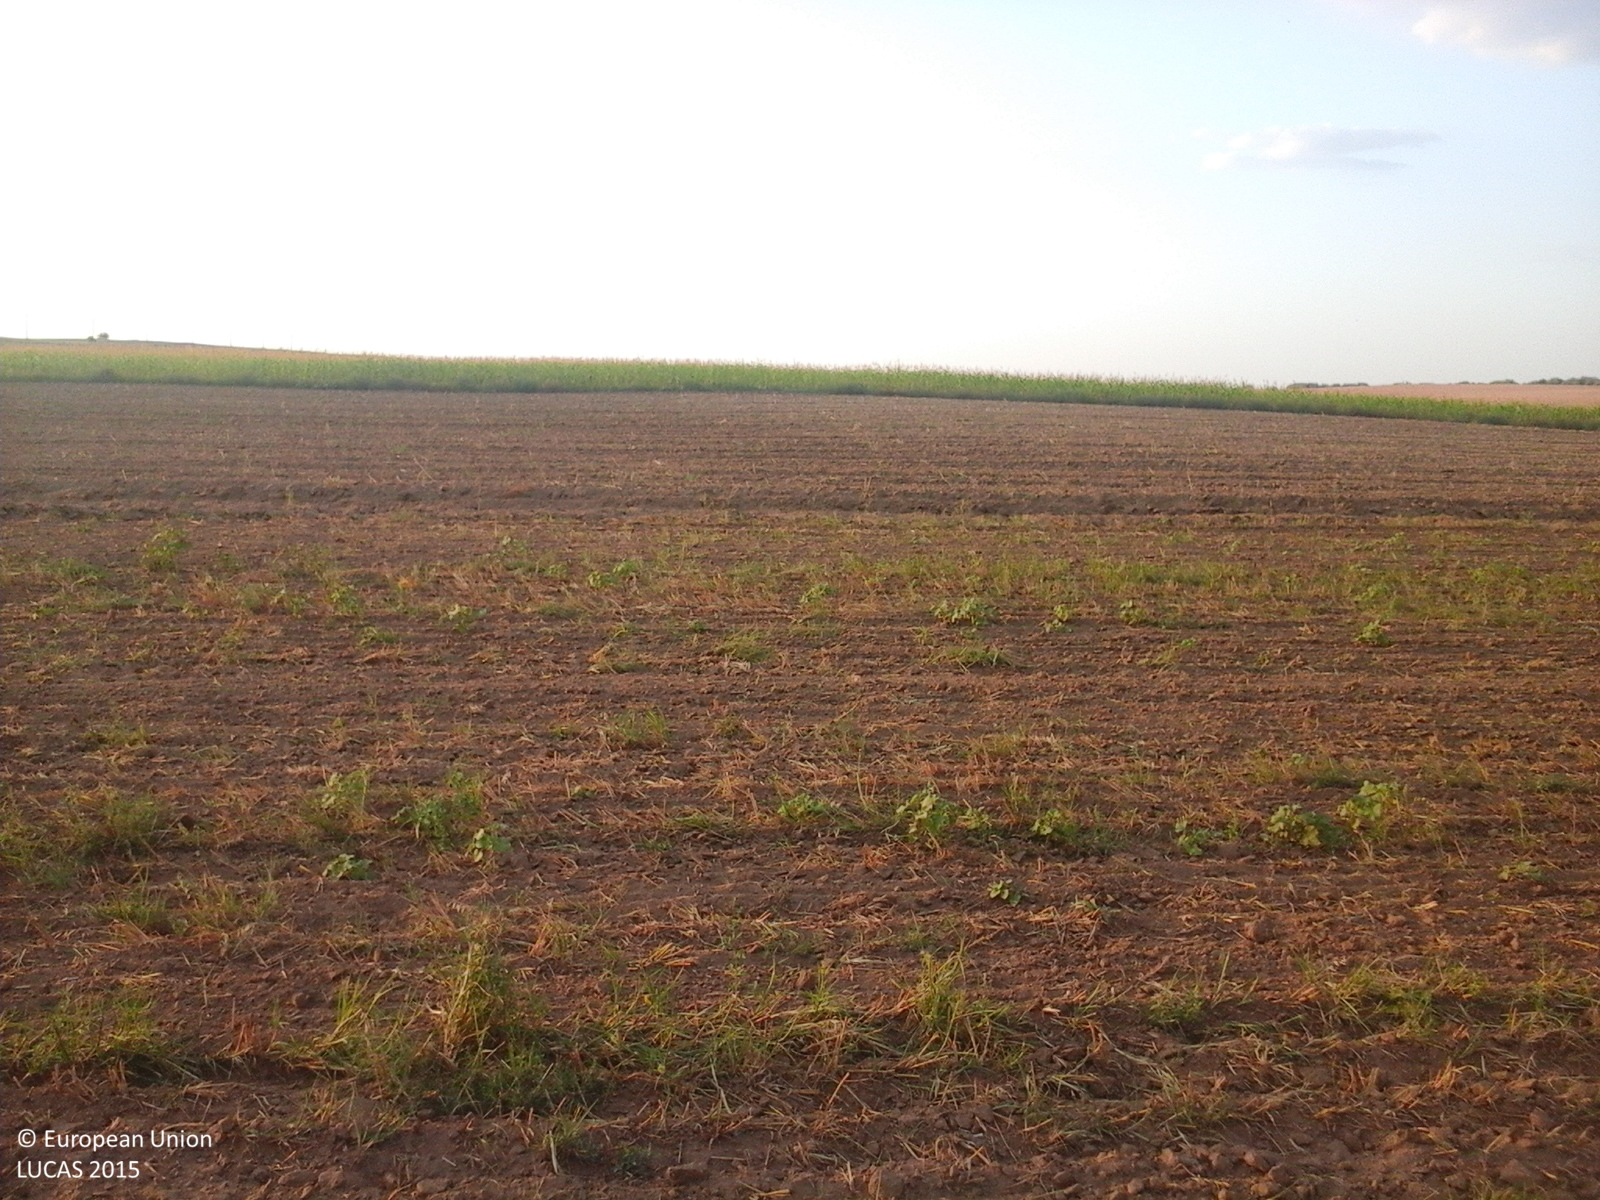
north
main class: Cropland
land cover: Common wheat
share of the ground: < 10 %
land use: Agriculture (excluding fallow land and kitchen gardens)
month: August
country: RO
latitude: 44.7073
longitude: 28.0468
